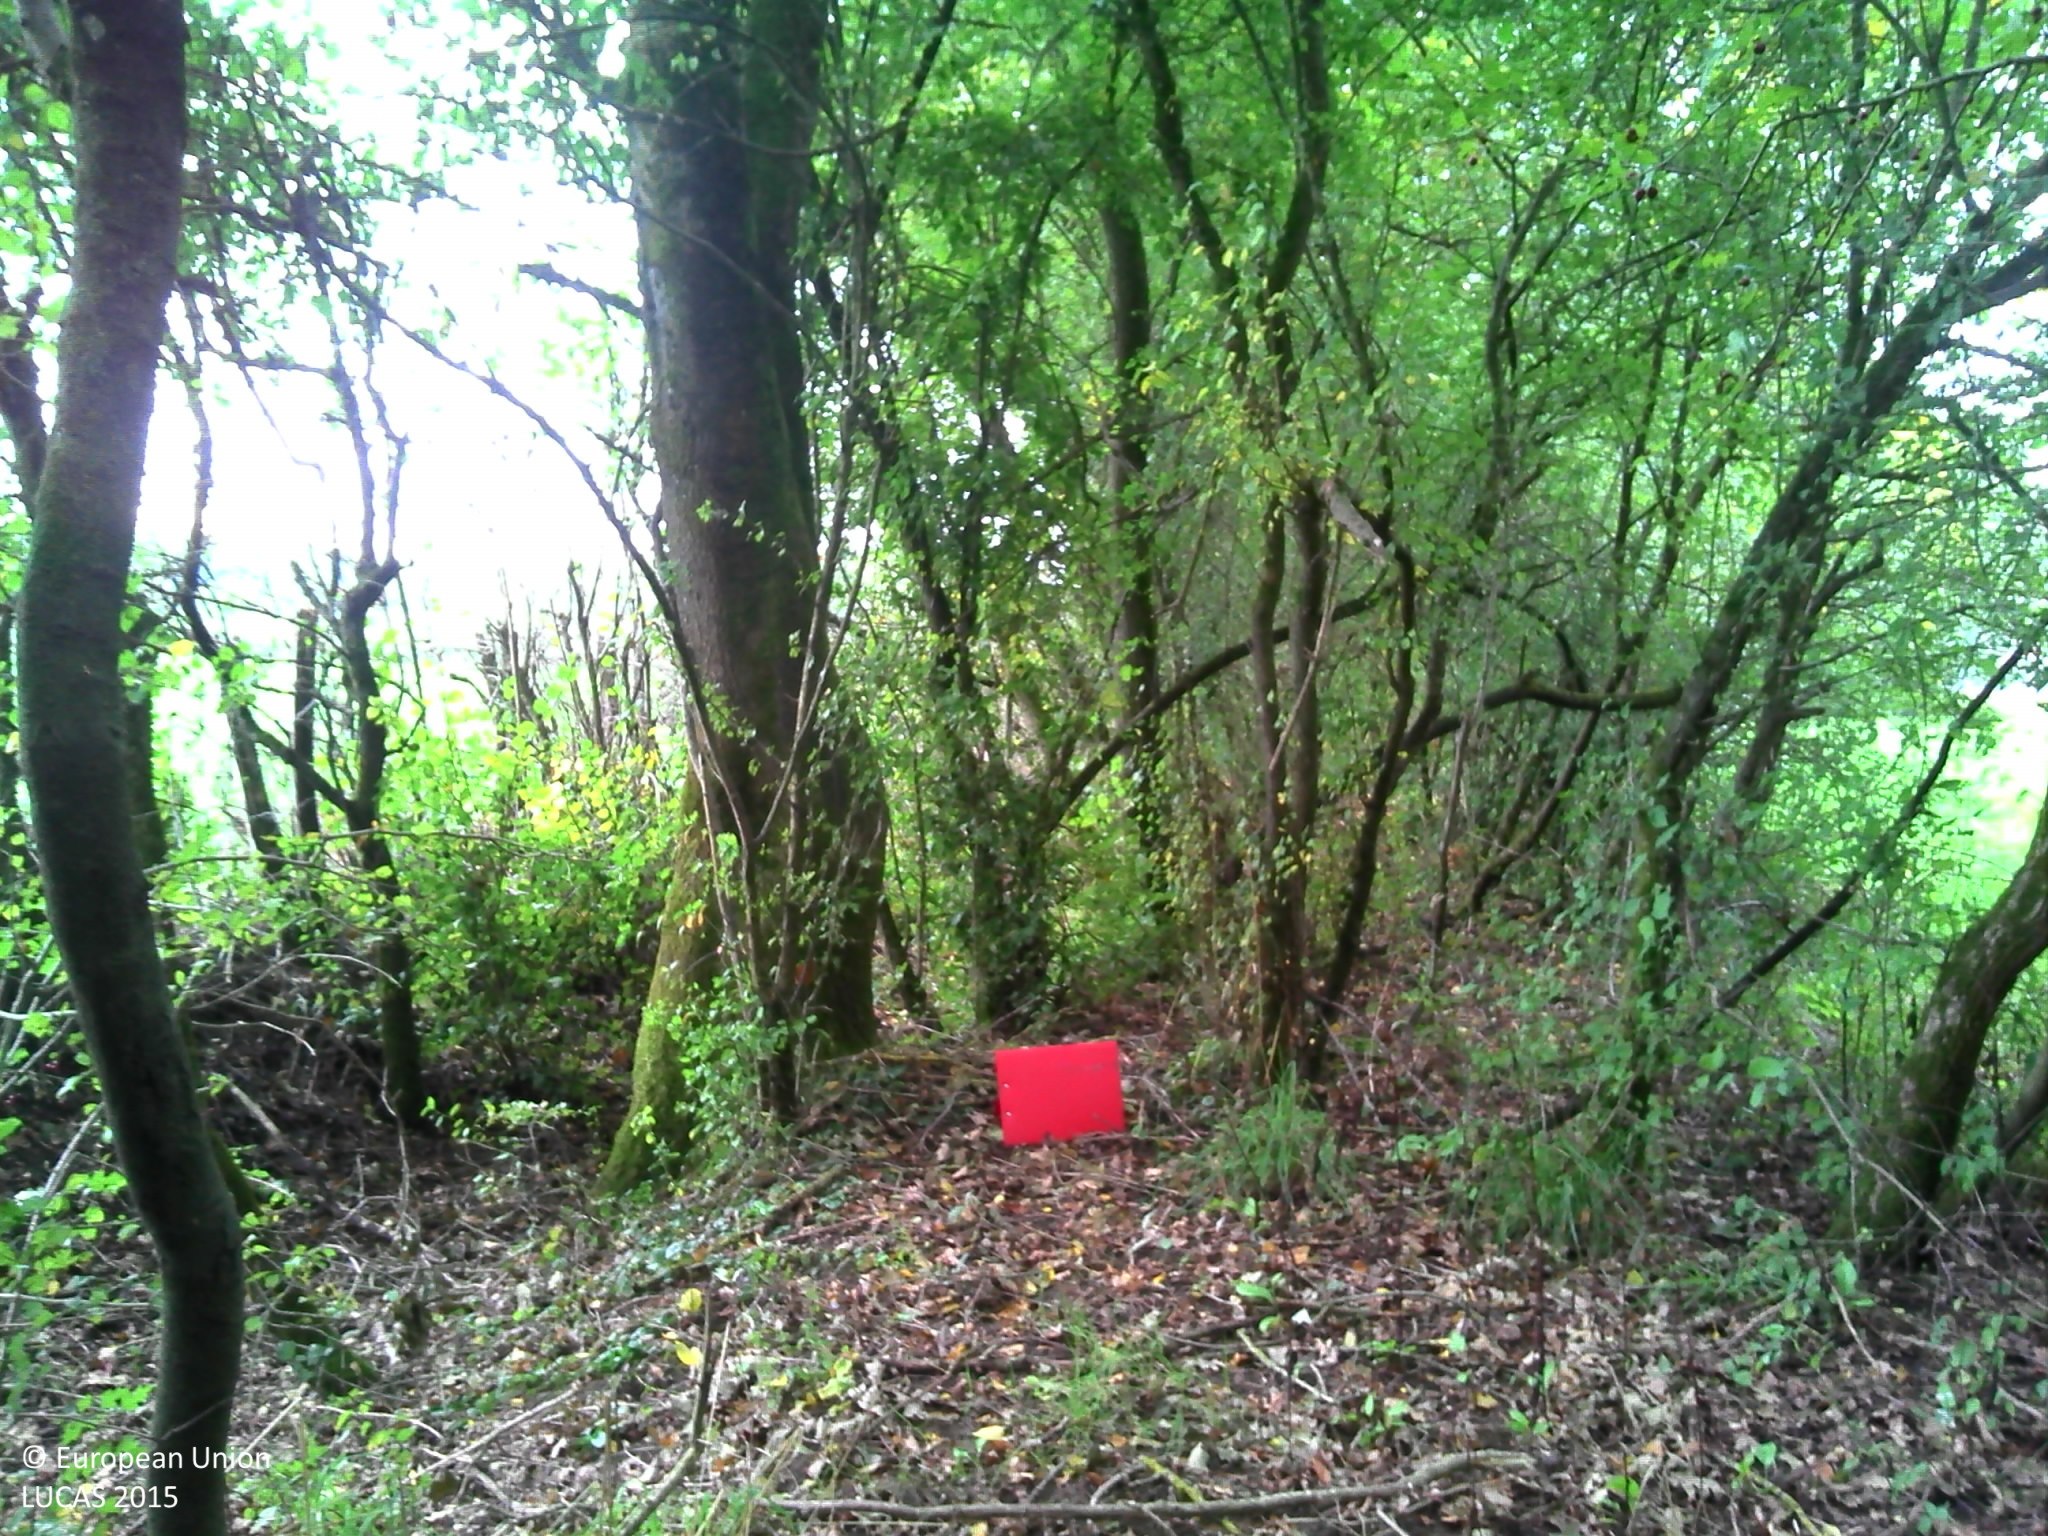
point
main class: Woodland
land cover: Broadleaved woodland
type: mesophytic deciduous forest
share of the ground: > 75 %
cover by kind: broadleaved forest trees 90 %, shrubs 10 %
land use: Forestry
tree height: > 5 m
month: October
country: FR
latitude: 46.5031
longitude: 4.9591
